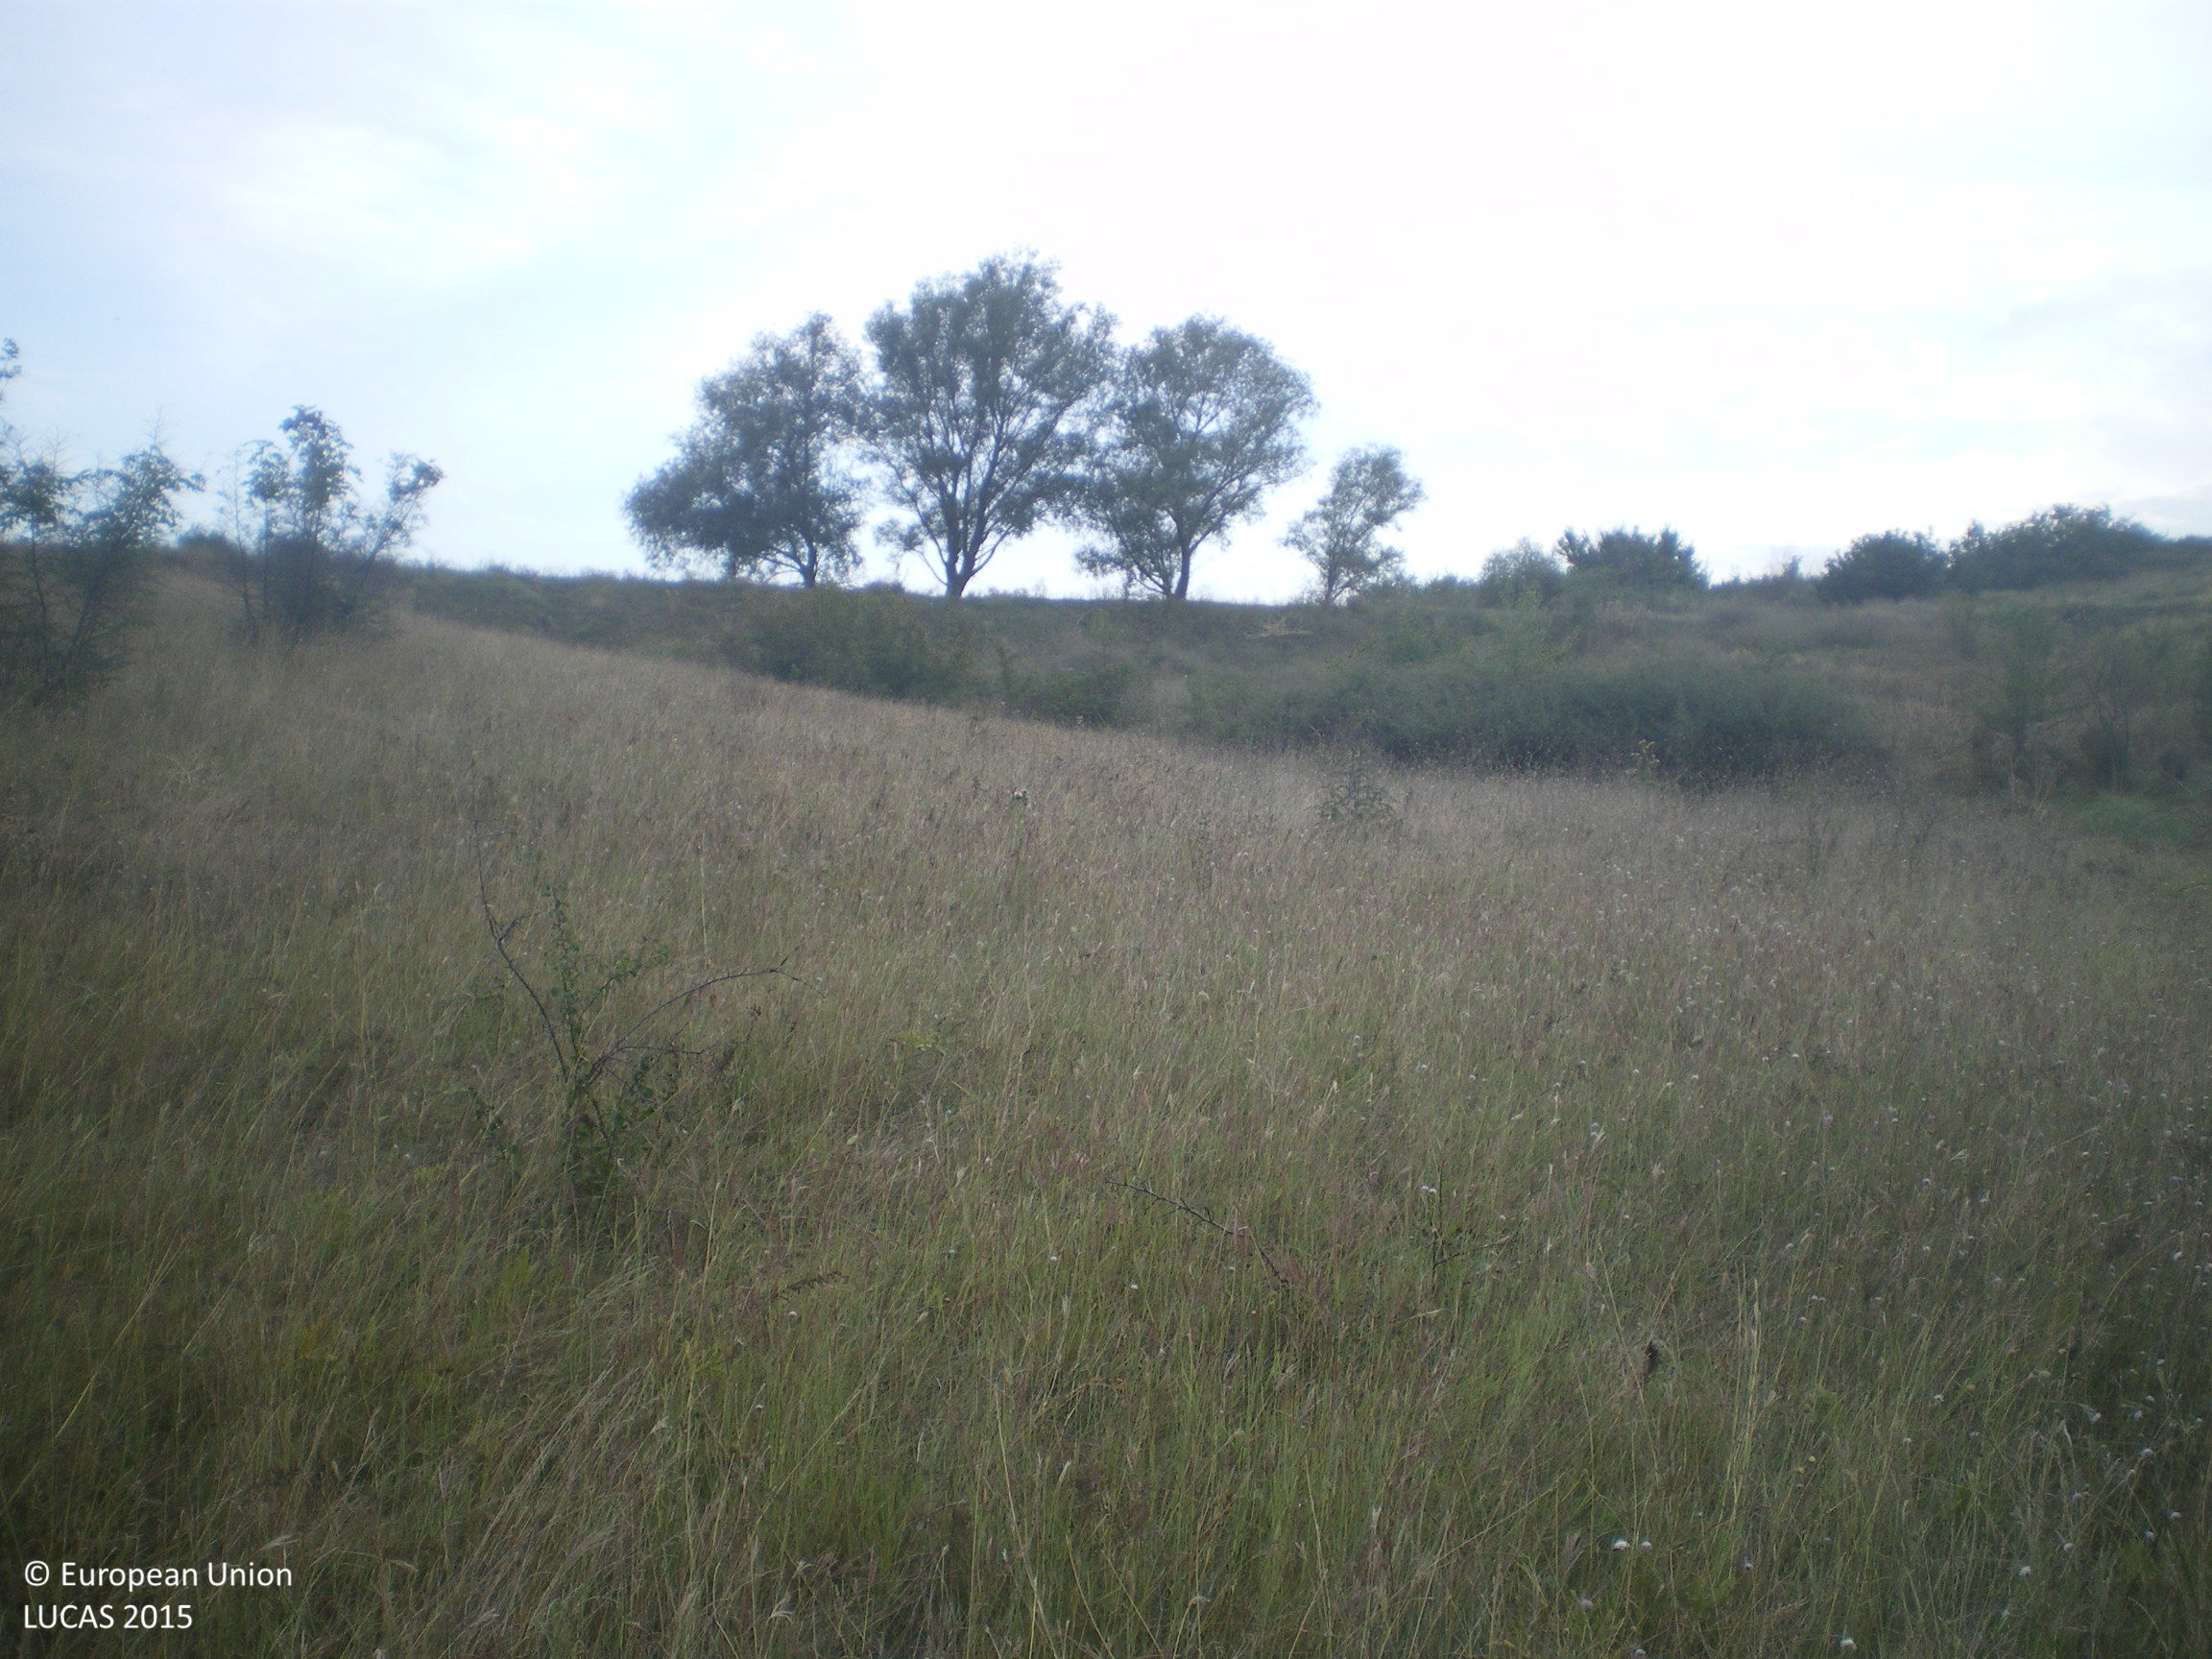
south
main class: Grassland
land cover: Grassland with sparse tree/shrub cover
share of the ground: > 75 %
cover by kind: herbaceous plants 90 %, broadleaved forest trees 5 %, shrubs 5 %
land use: Agriculture (excluding fallow land and kitchen gardens)
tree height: > 5 m
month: September
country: BG
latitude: 42.1323
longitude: 25.9598
